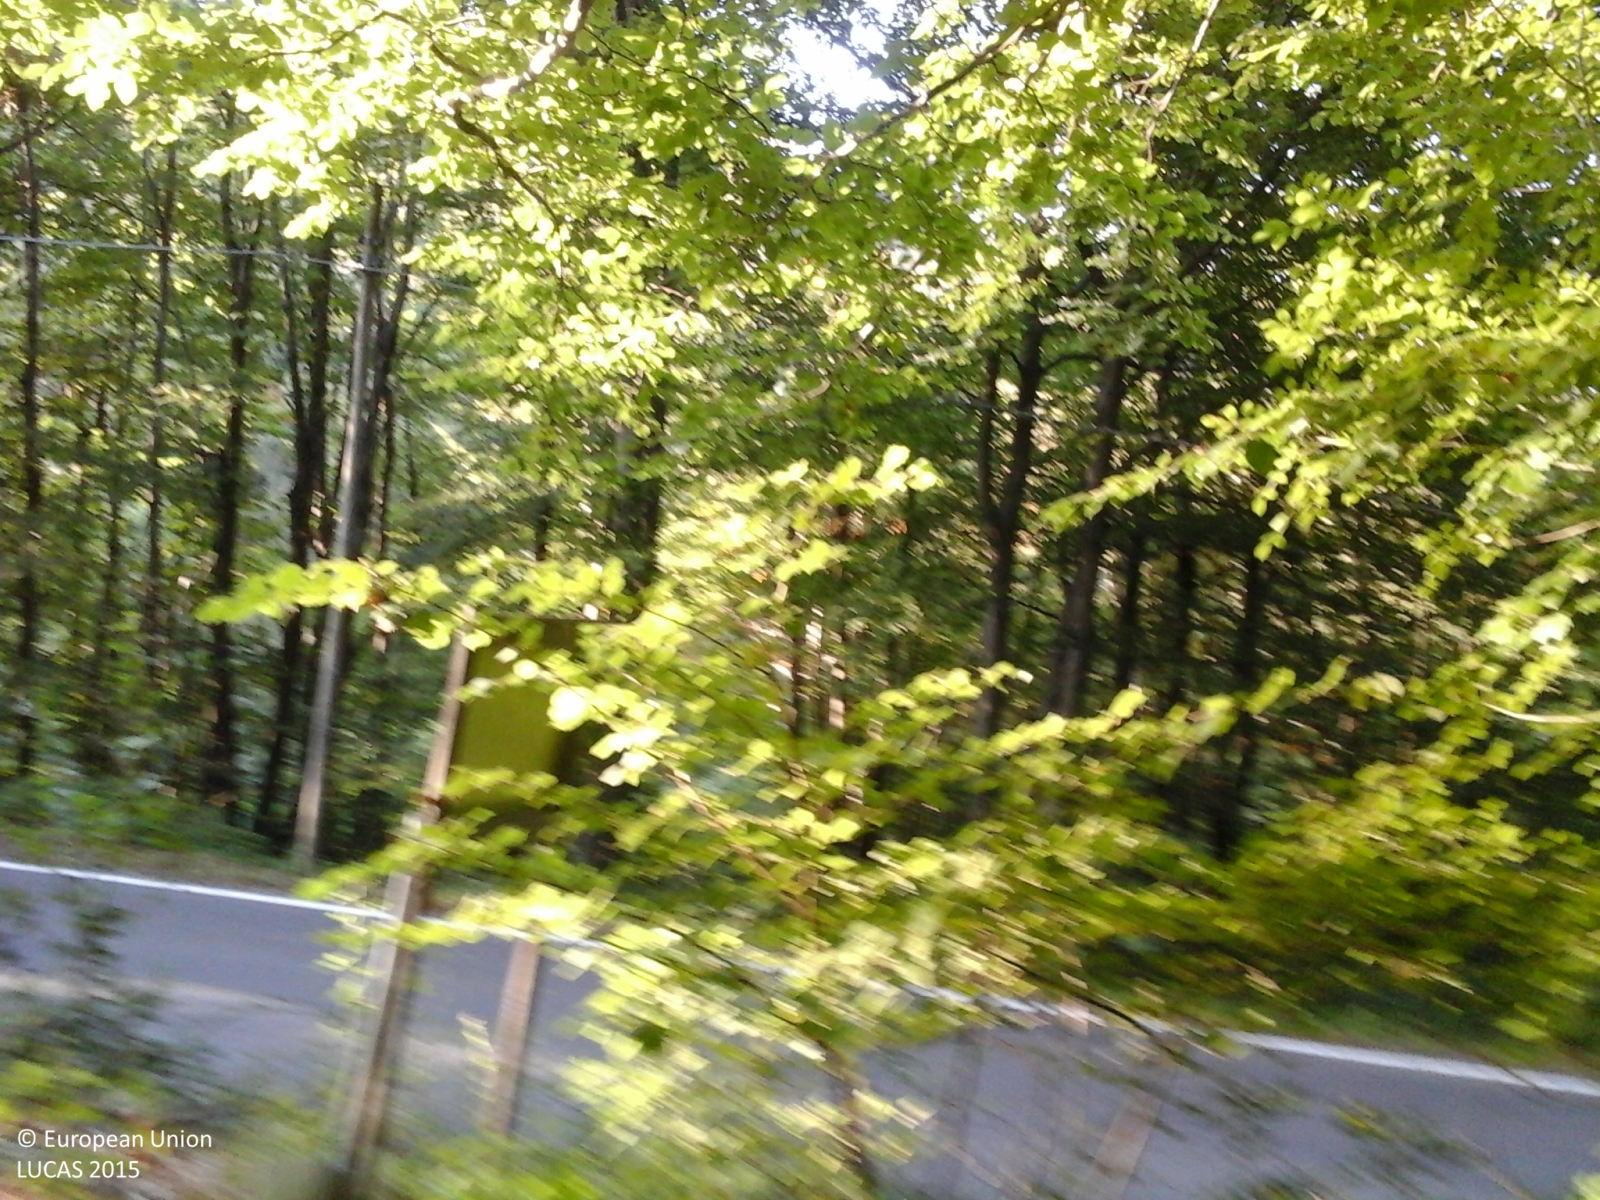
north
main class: Woodland
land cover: Broadleaved woodland
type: beech forest
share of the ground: > 75 %
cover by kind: broadleaved forest trees 100 %
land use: Semi-natural and natural areas not in use
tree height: > 5 m
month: September
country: IT
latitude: 44.3929
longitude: 8.4342
